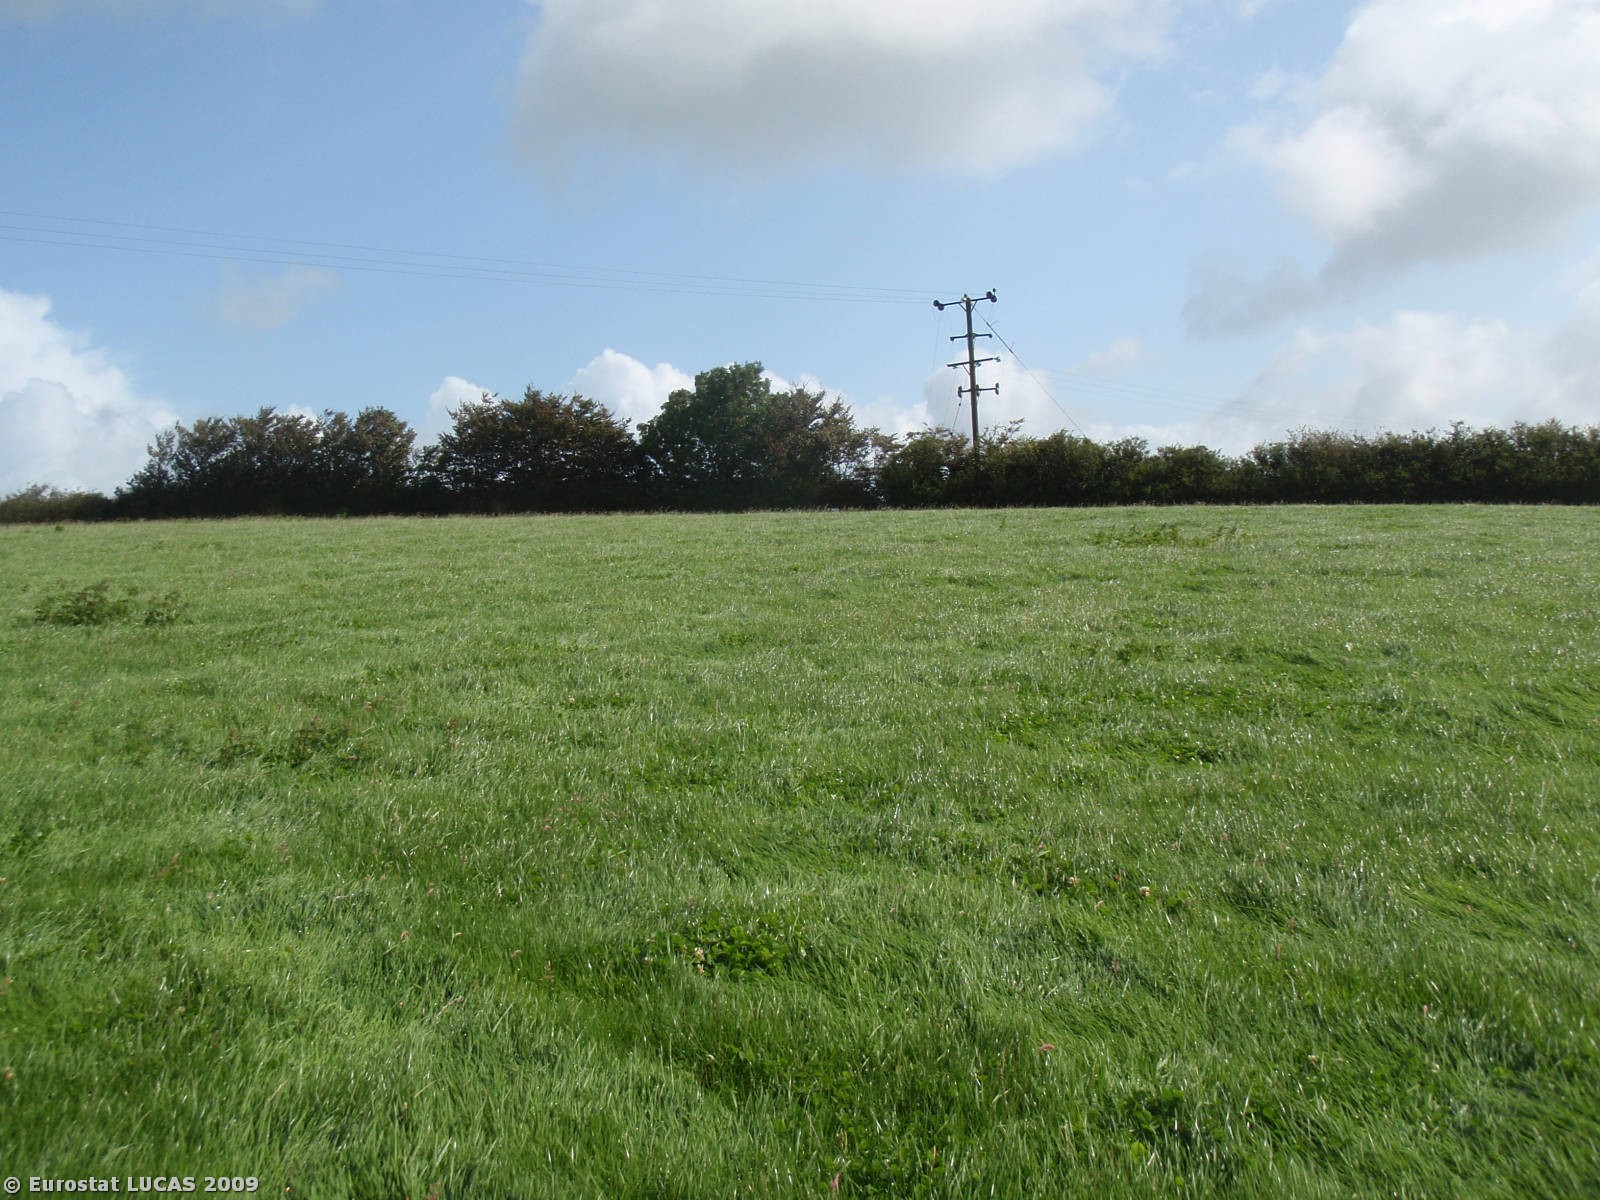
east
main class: Grassland
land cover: Grassland without tree/shrub cover
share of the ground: > 75 %
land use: Agriculture (excluding fallow land and kitchen gardens)
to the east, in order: Grassland without tree/shrub cover; Fences; Managed hedges; Grassland without tree/shrub cover; Managed hedges; Artificial constructions in urban areas
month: August
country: GB
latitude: 51.1415
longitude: -3.5350
